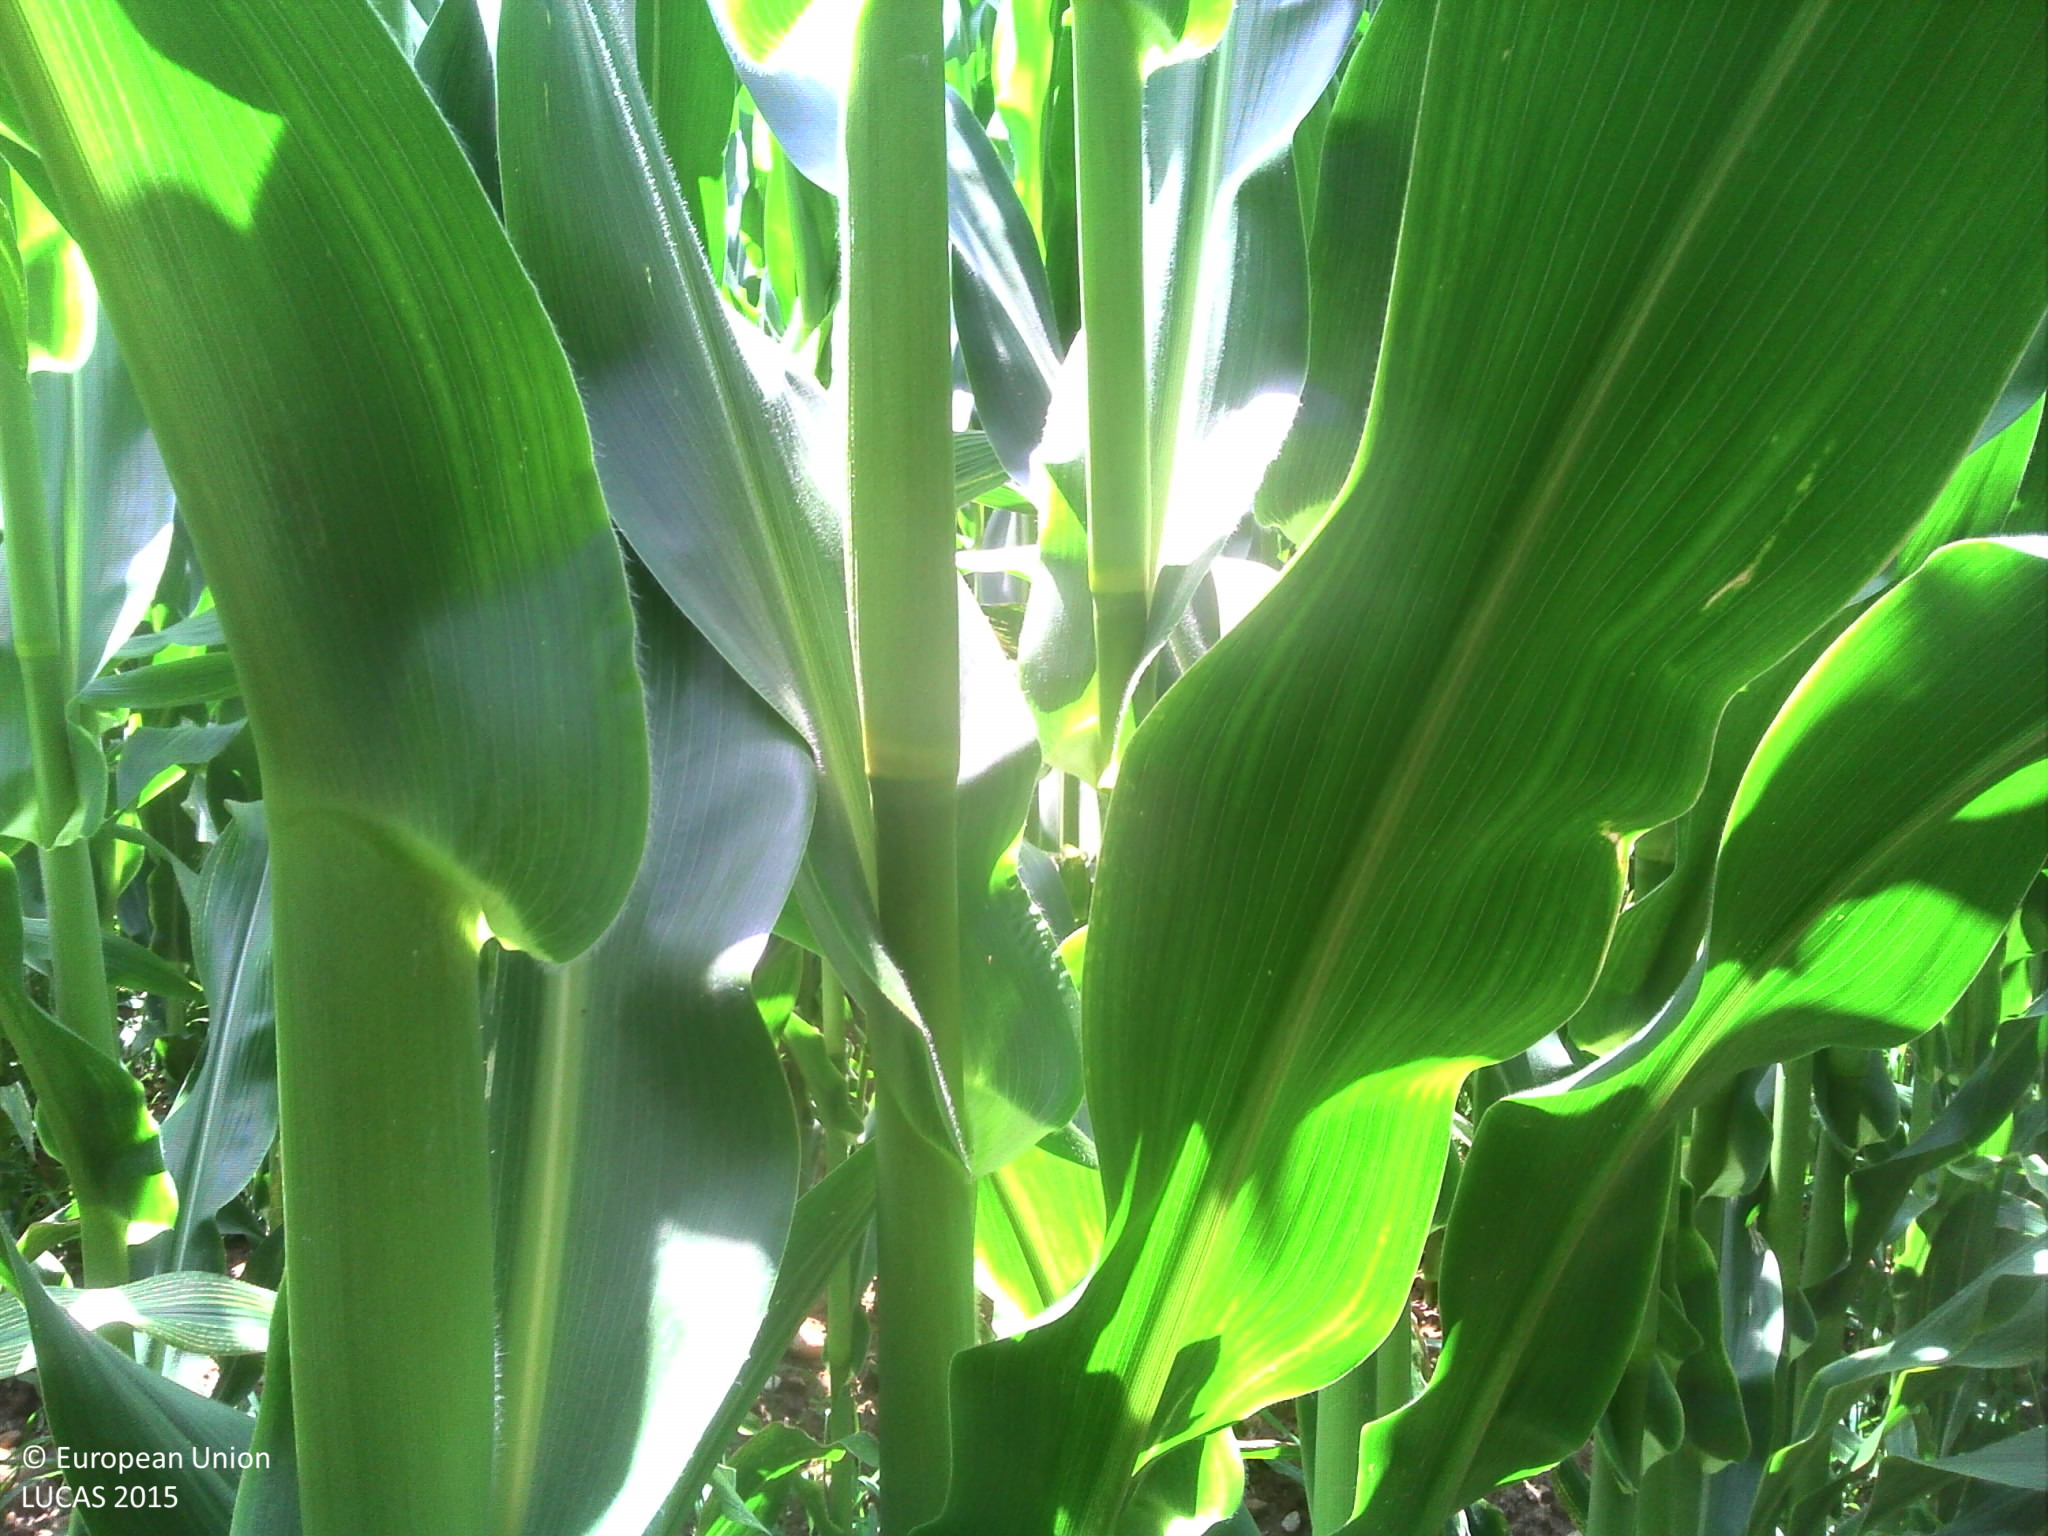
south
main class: Cropland
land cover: Maize
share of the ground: > 75 %
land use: Agriculture (excluding fallow land and kitchen gardens)
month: July
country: FR
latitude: 45.8332
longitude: 5.3049
